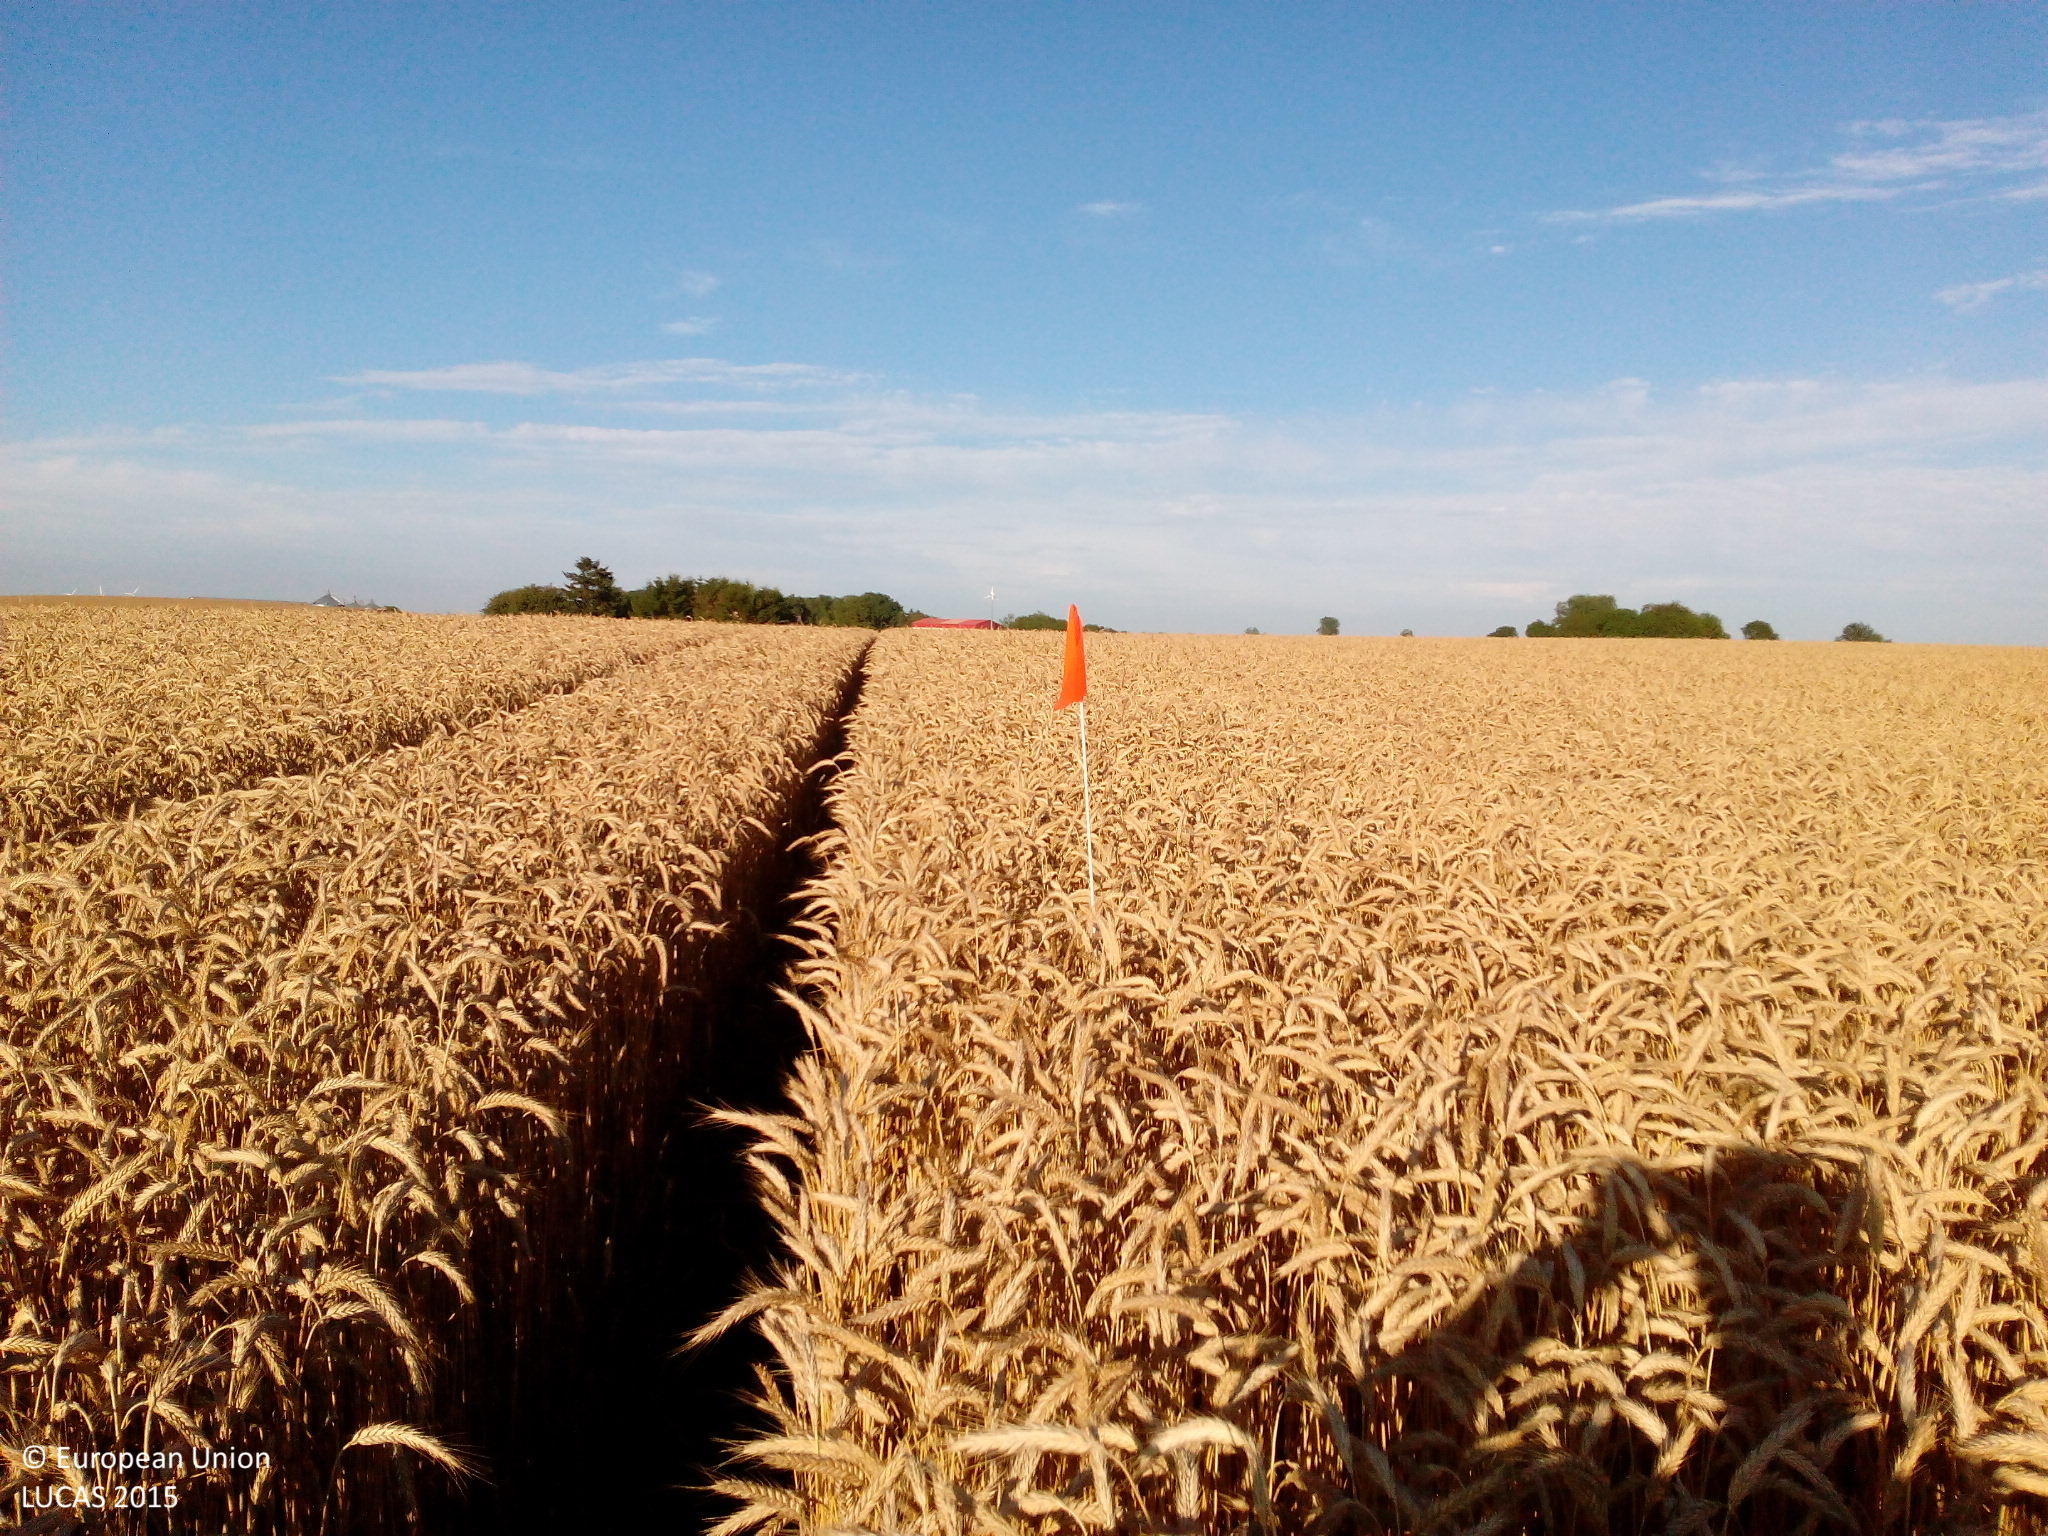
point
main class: Cropland
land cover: Common wheat
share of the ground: > 75 %
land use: Agriculture (excluding fallow land and kitchen gardens)
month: August
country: DK
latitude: 55.5648
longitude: 11.7269
